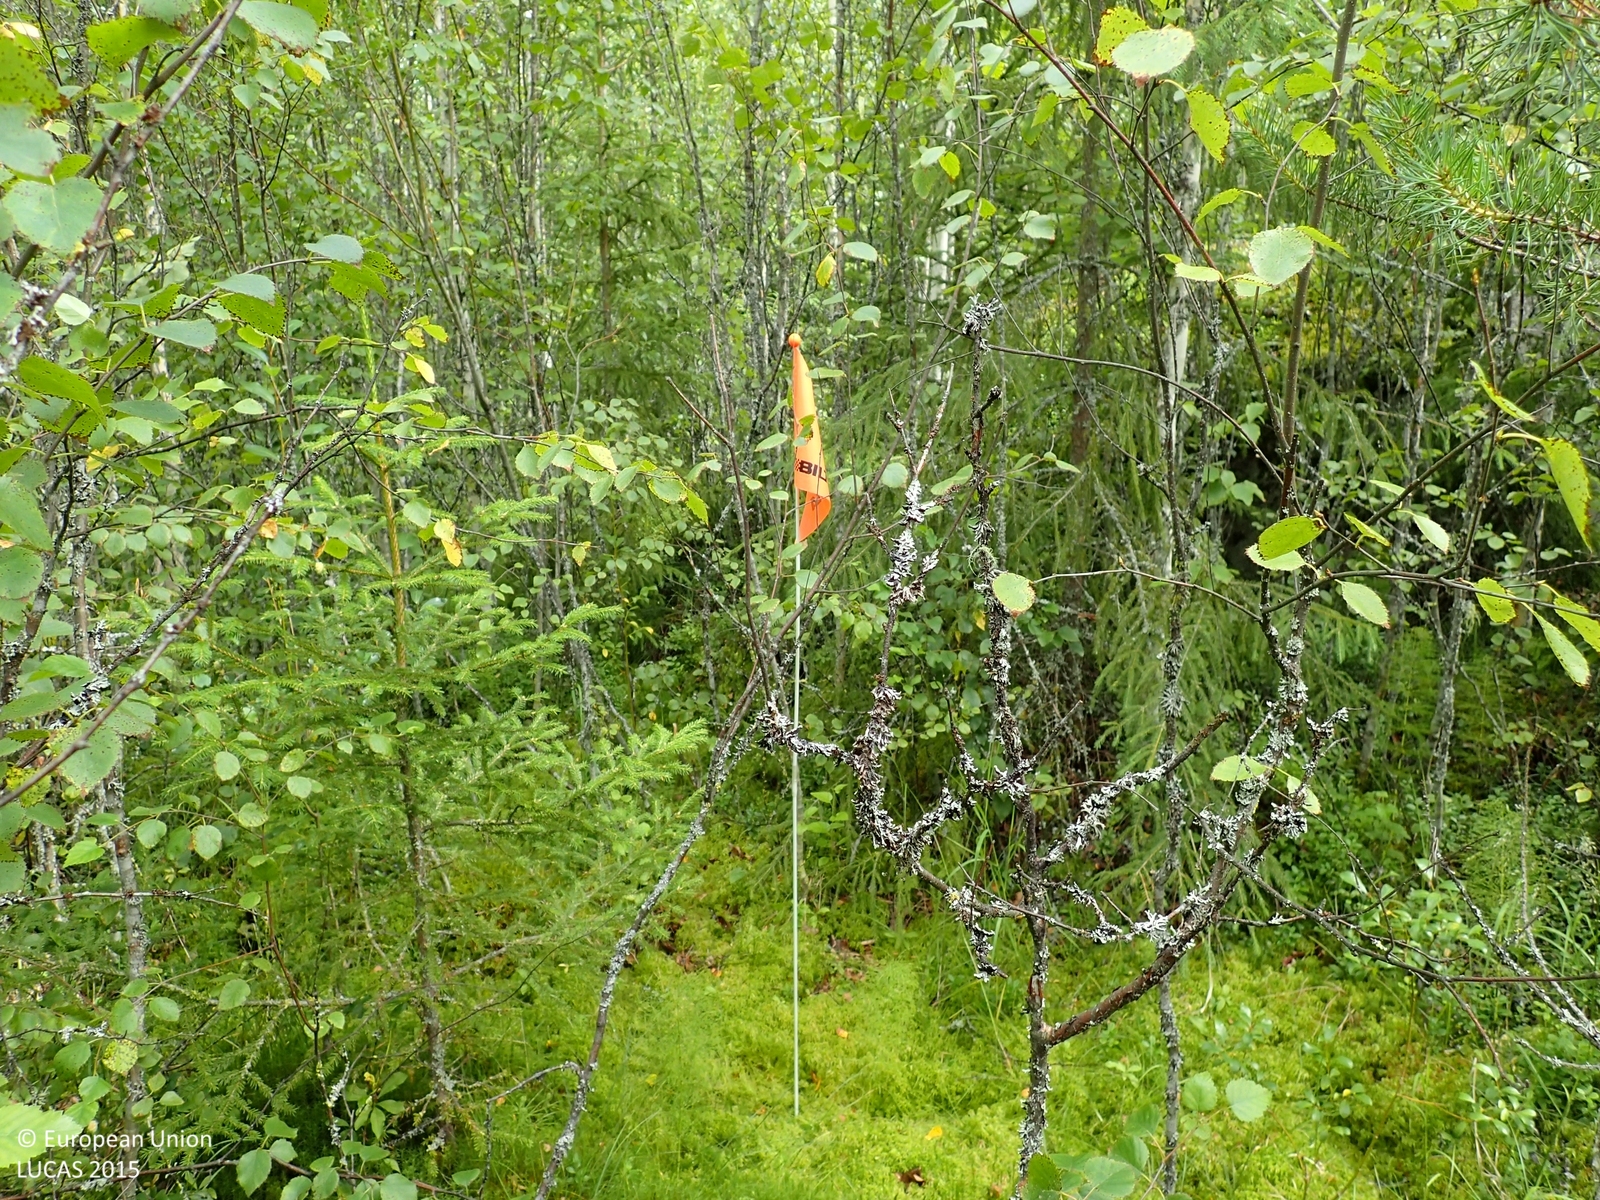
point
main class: Woodland
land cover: Broadleaved woodland
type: non-riverine alder, birch or aspen forest
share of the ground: > 75 %
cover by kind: broadleaved forest trees 80 %, coniferous forest trees 10 %, shrubs 5 %, herbaceous plants 5 %
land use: Forestry
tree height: < 5 m
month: July
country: FI
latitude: 62.8489
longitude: 22.6057
